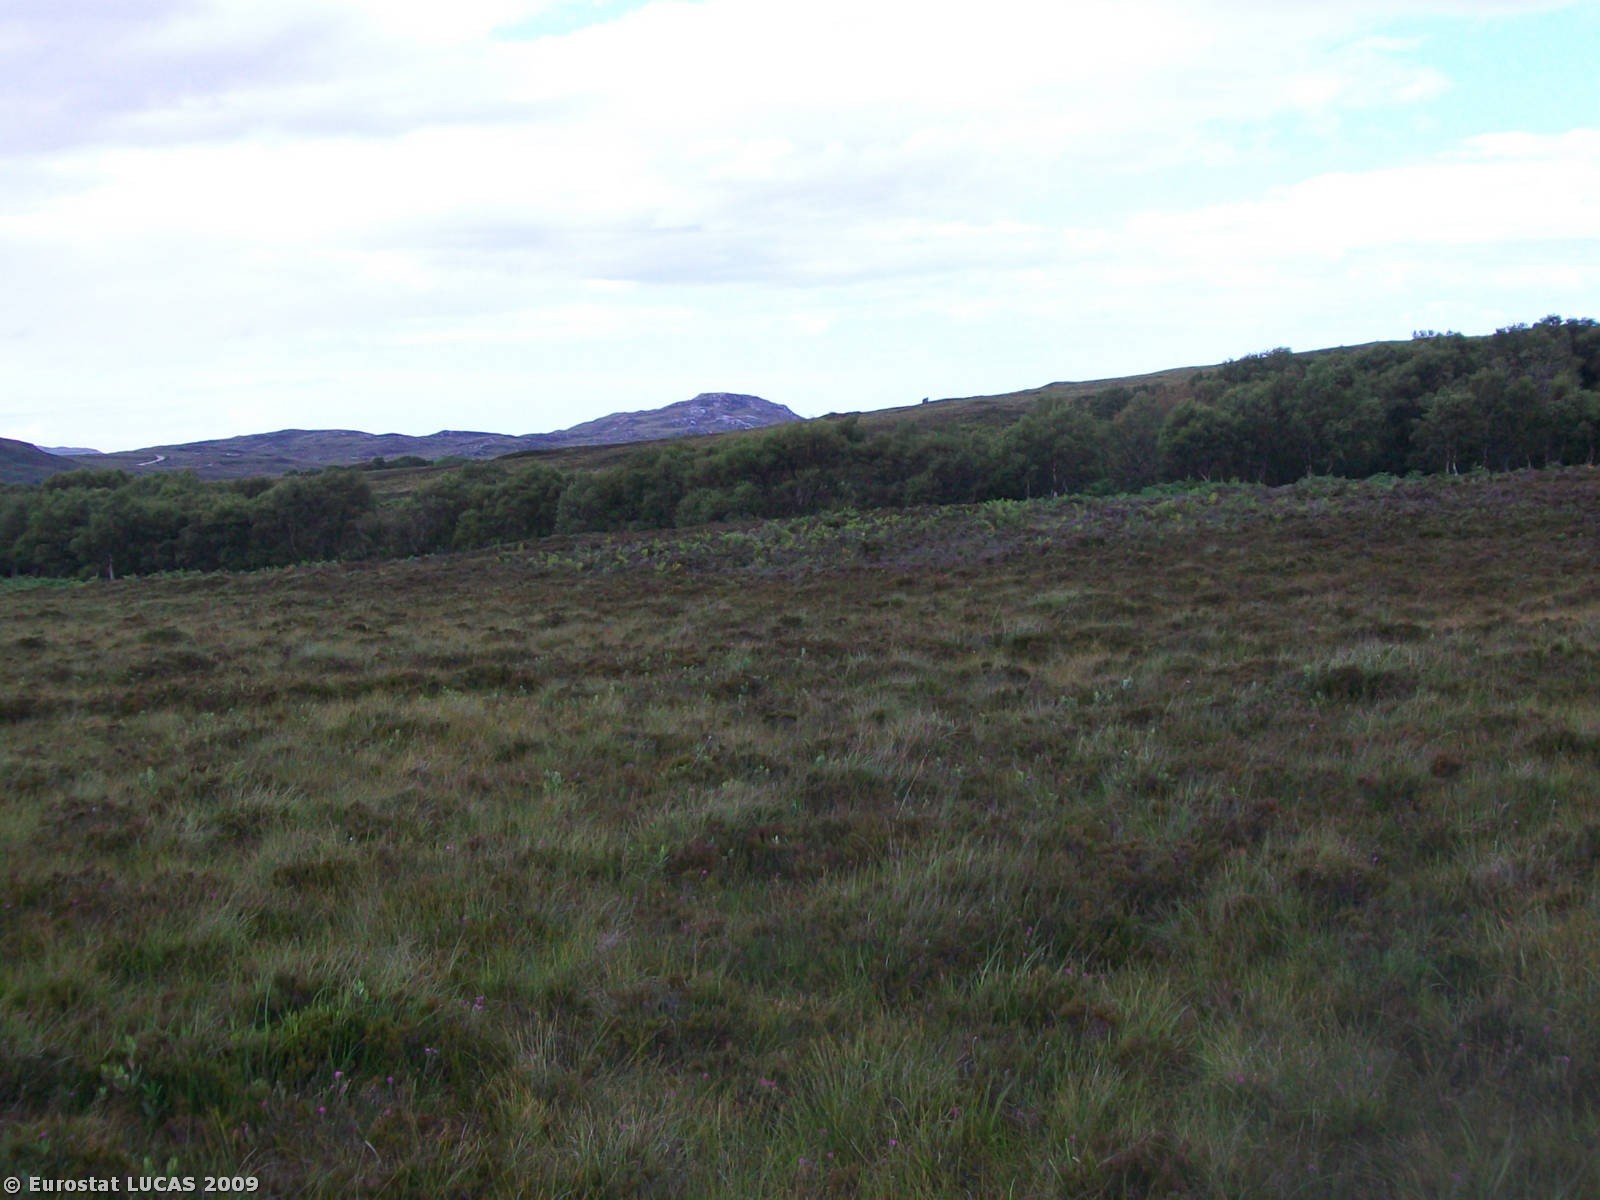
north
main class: Shrubland
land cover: Shrubland without tree cover
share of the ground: > 75 %
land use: Agriculture (excluding fallow land and kitchen gardens)
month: July
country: GB
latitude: 58.4779
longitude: -4.6124
